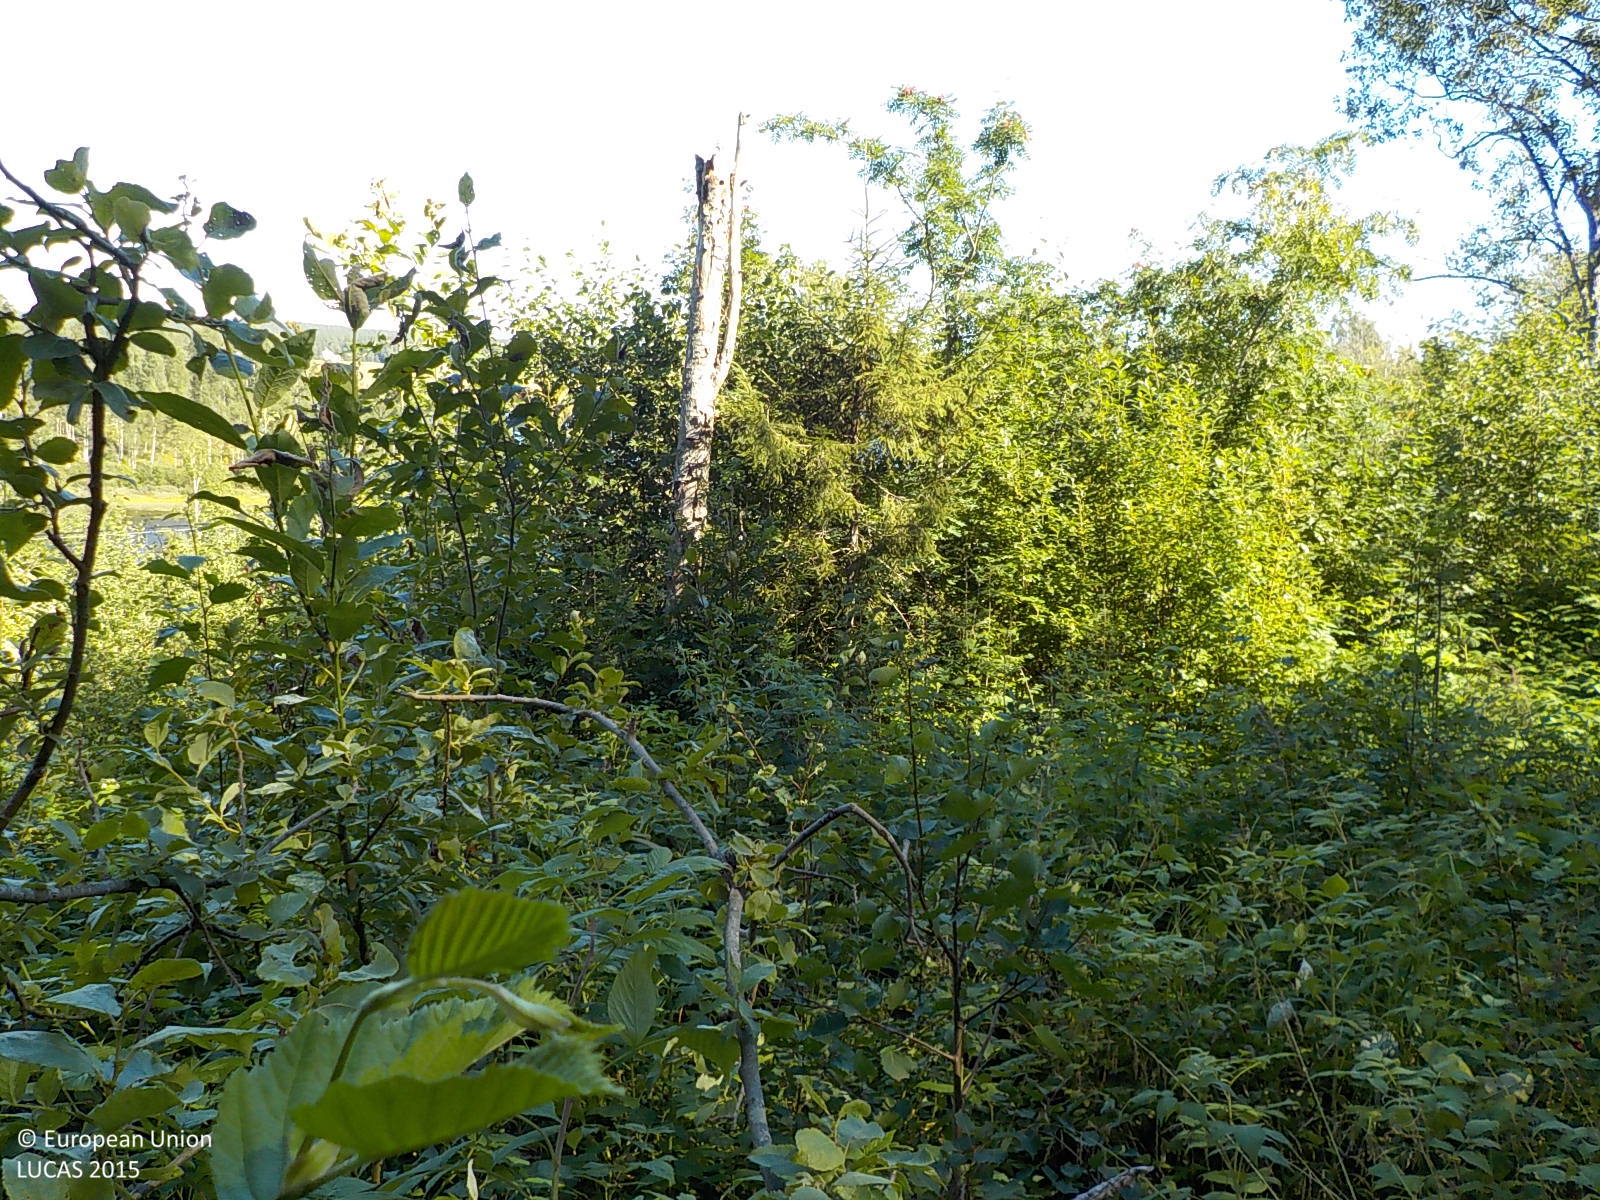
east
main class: Woodland
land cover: Broadleaved woodland
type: hemiboreal forest and nemoral coniferous forest and mixed broadleaved-coniferous forest
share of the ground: > 75 %
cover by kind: broadleaved forest trees 85 %, herbaceous plants 15 %
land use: Forestry
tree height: < 5 m
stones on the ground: 10 - 25 %
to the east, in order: Broadleaved woodland; Grass margins; Paved roads, cycling and walking lanes; Grass margins; Electric lines; Broadleaved woodland; Ditches and canals; Broadleaved woodland
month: August
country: SE
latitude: 63.3318
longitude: 18.8654
